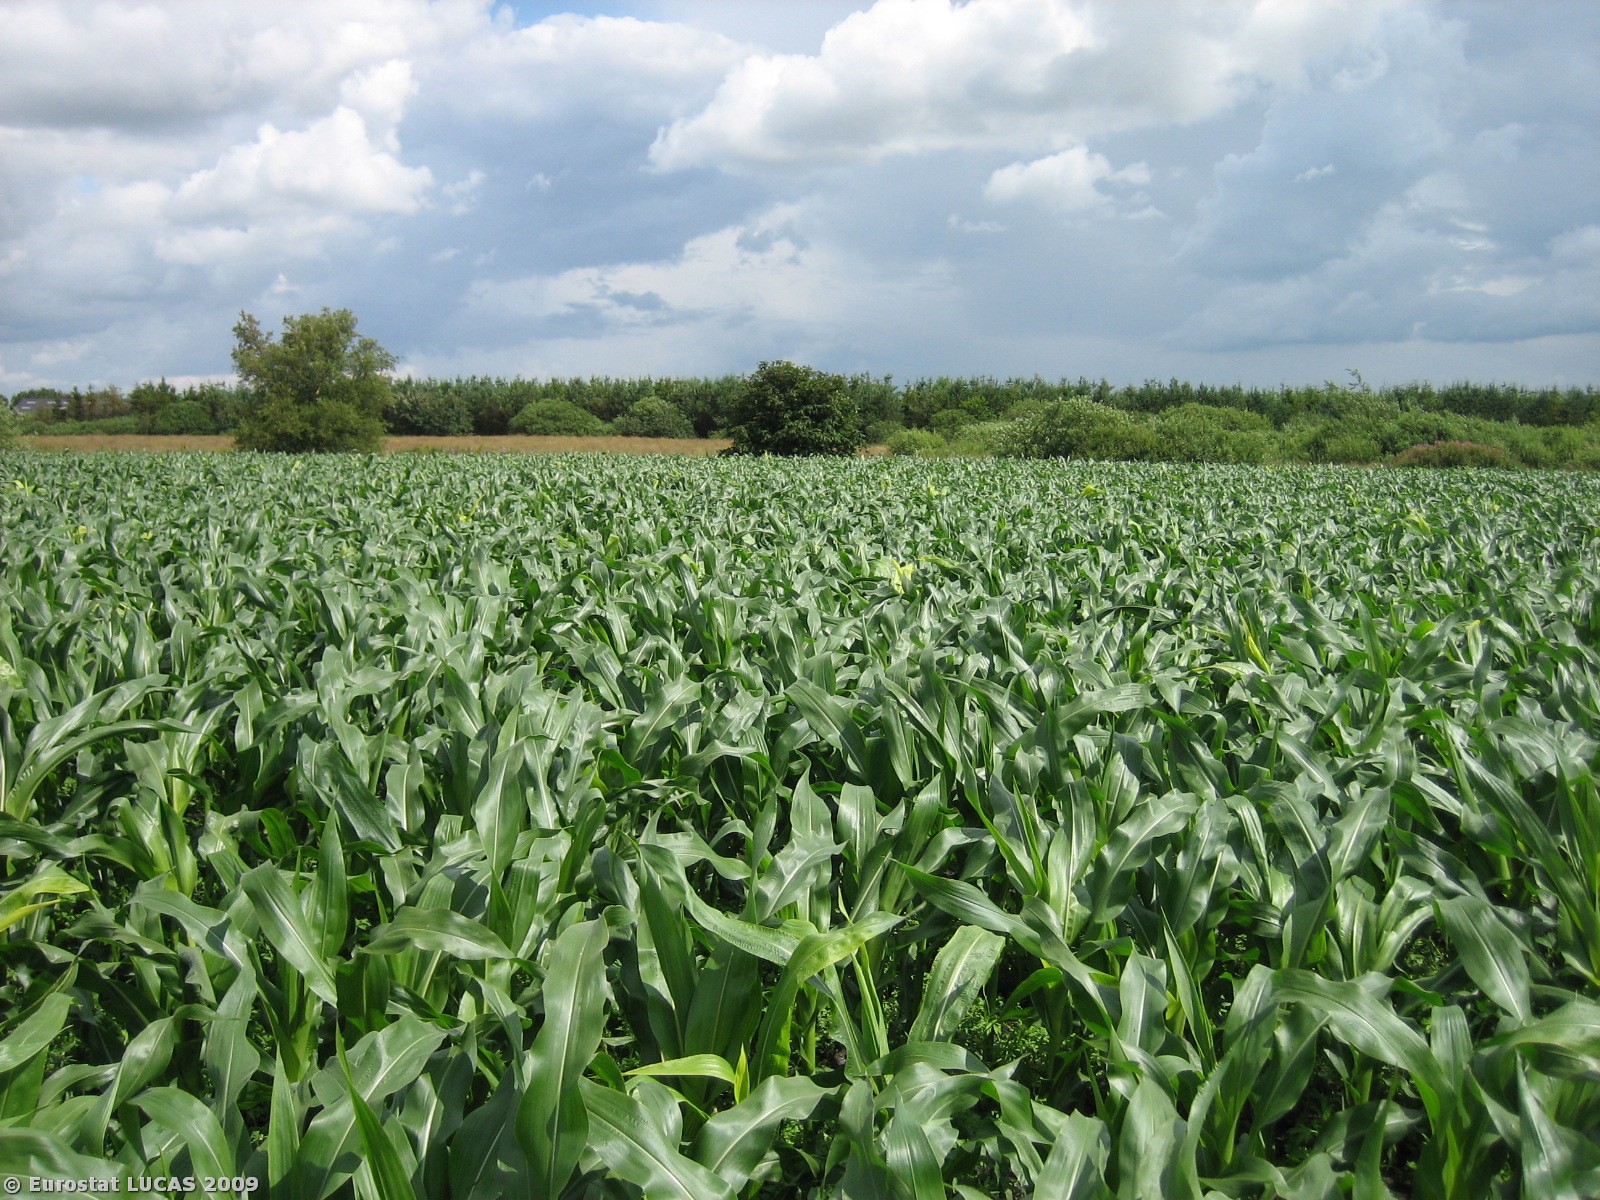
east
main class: Cropland
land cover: Maize
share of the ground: 25 - 50 %
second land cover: Spontaneously vegetated surfaces
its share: > 75 %
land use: Agriculture (excluding fallow land and kitchen gardens)
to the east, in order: Maize; Spontaneously vegetated surfaces; Single bushes/trees; Grassland without tree/shrub cover; Fences; Ditches and canals; Broadleaved woodland; Coniferous woodland; Grassland without tree/shrub cover; Coniferous woodland; Grassland without tree/shrub cover; Shrubland without tree cover; Temporary grasslands
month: July
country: DK
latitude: 55.6426
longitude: 8.7778
